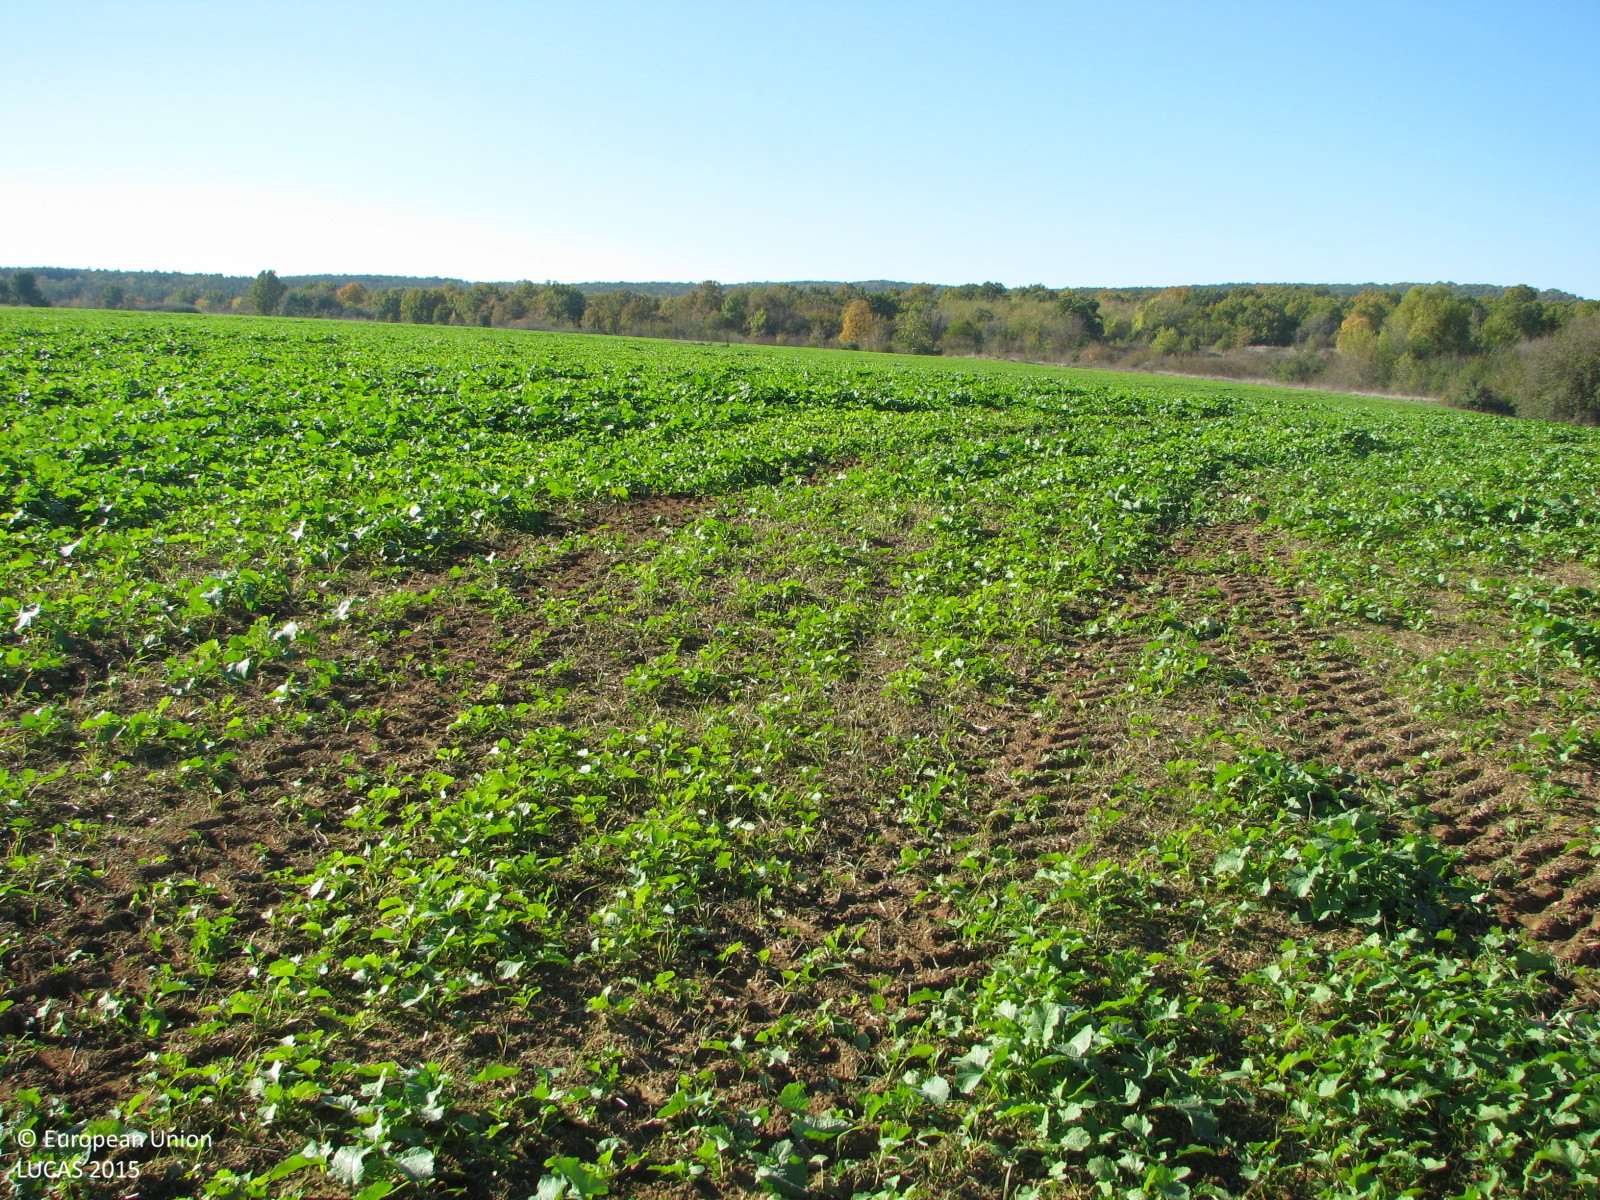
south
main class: Cropland
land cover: Rape and turnip rape
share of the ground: > 75 %
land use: Agriculture (excluding fallow land and kitchen gardens)
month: November
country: BG
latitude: 42.1186
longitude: 26.8228
